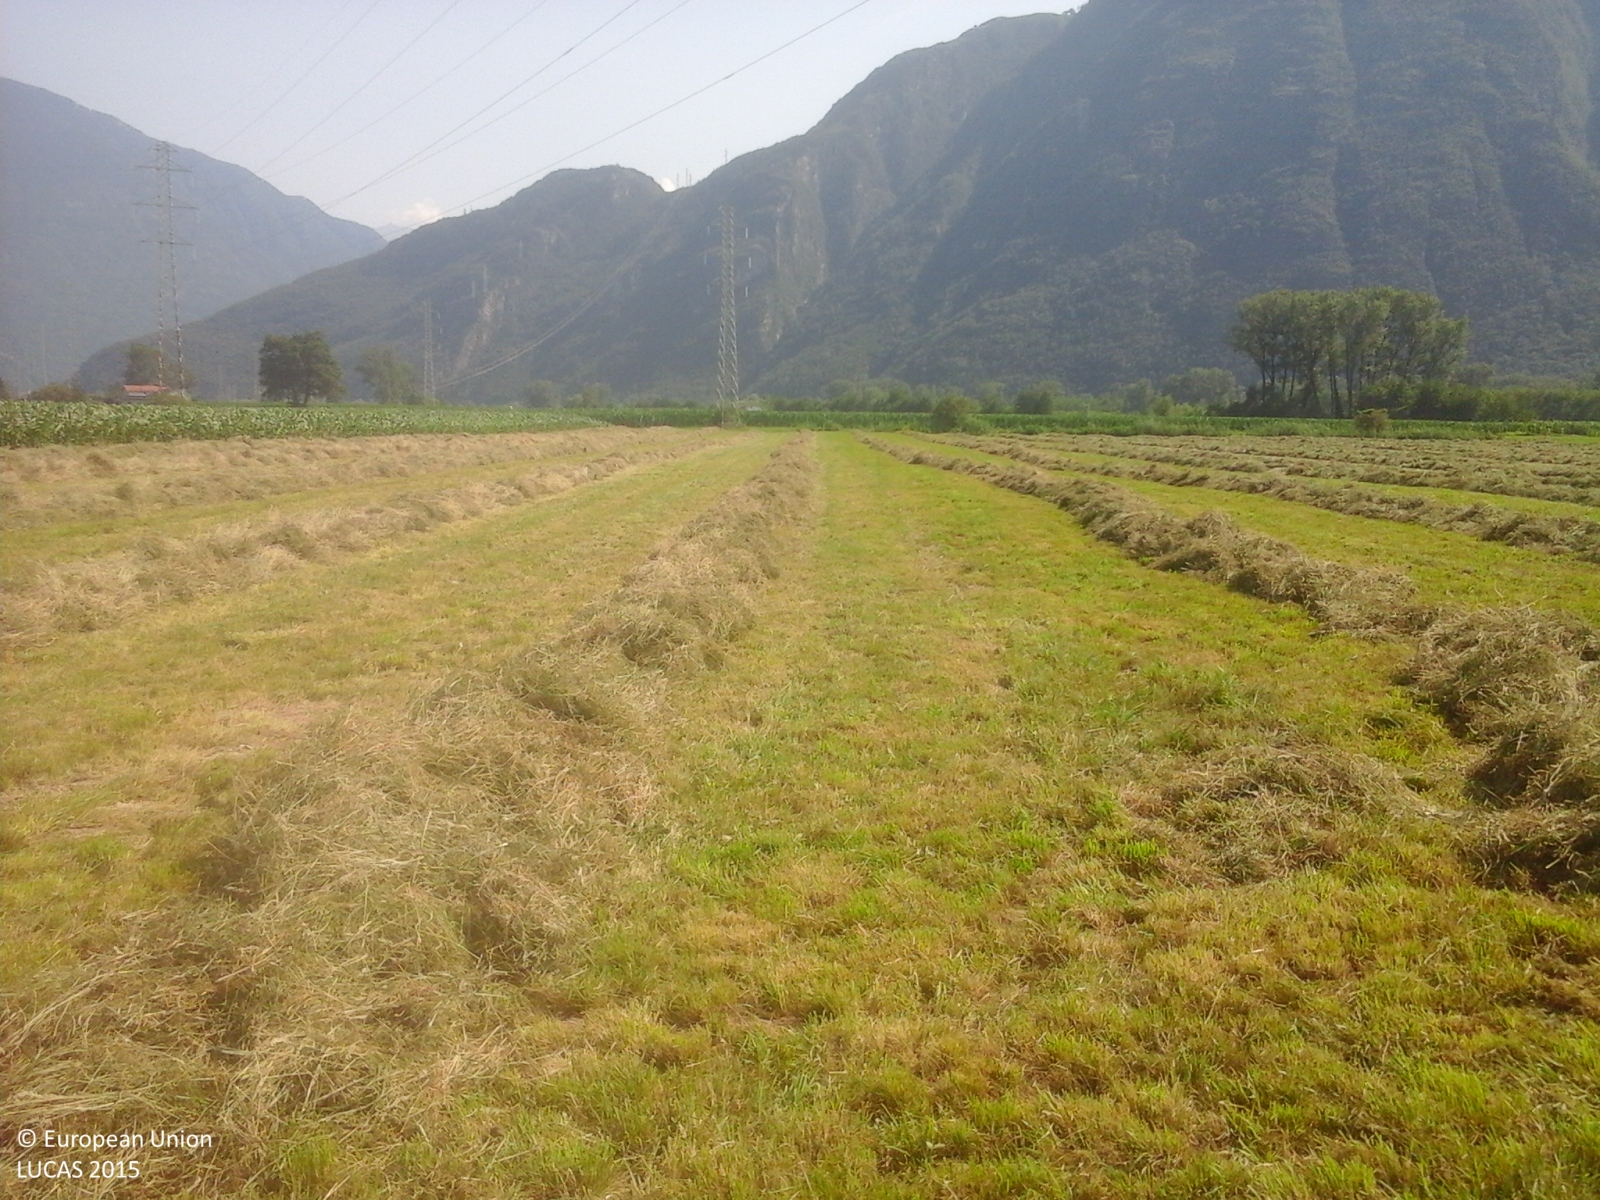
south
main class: Grassland
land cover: Grassland without tree/shrub cover
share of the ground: > 75 %
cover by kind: herbaceous plants 100 %
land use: Agriculture (excluding fallow land and kitchen gardens)
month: July
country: IT
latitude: 46.2415
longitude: 9.4172
